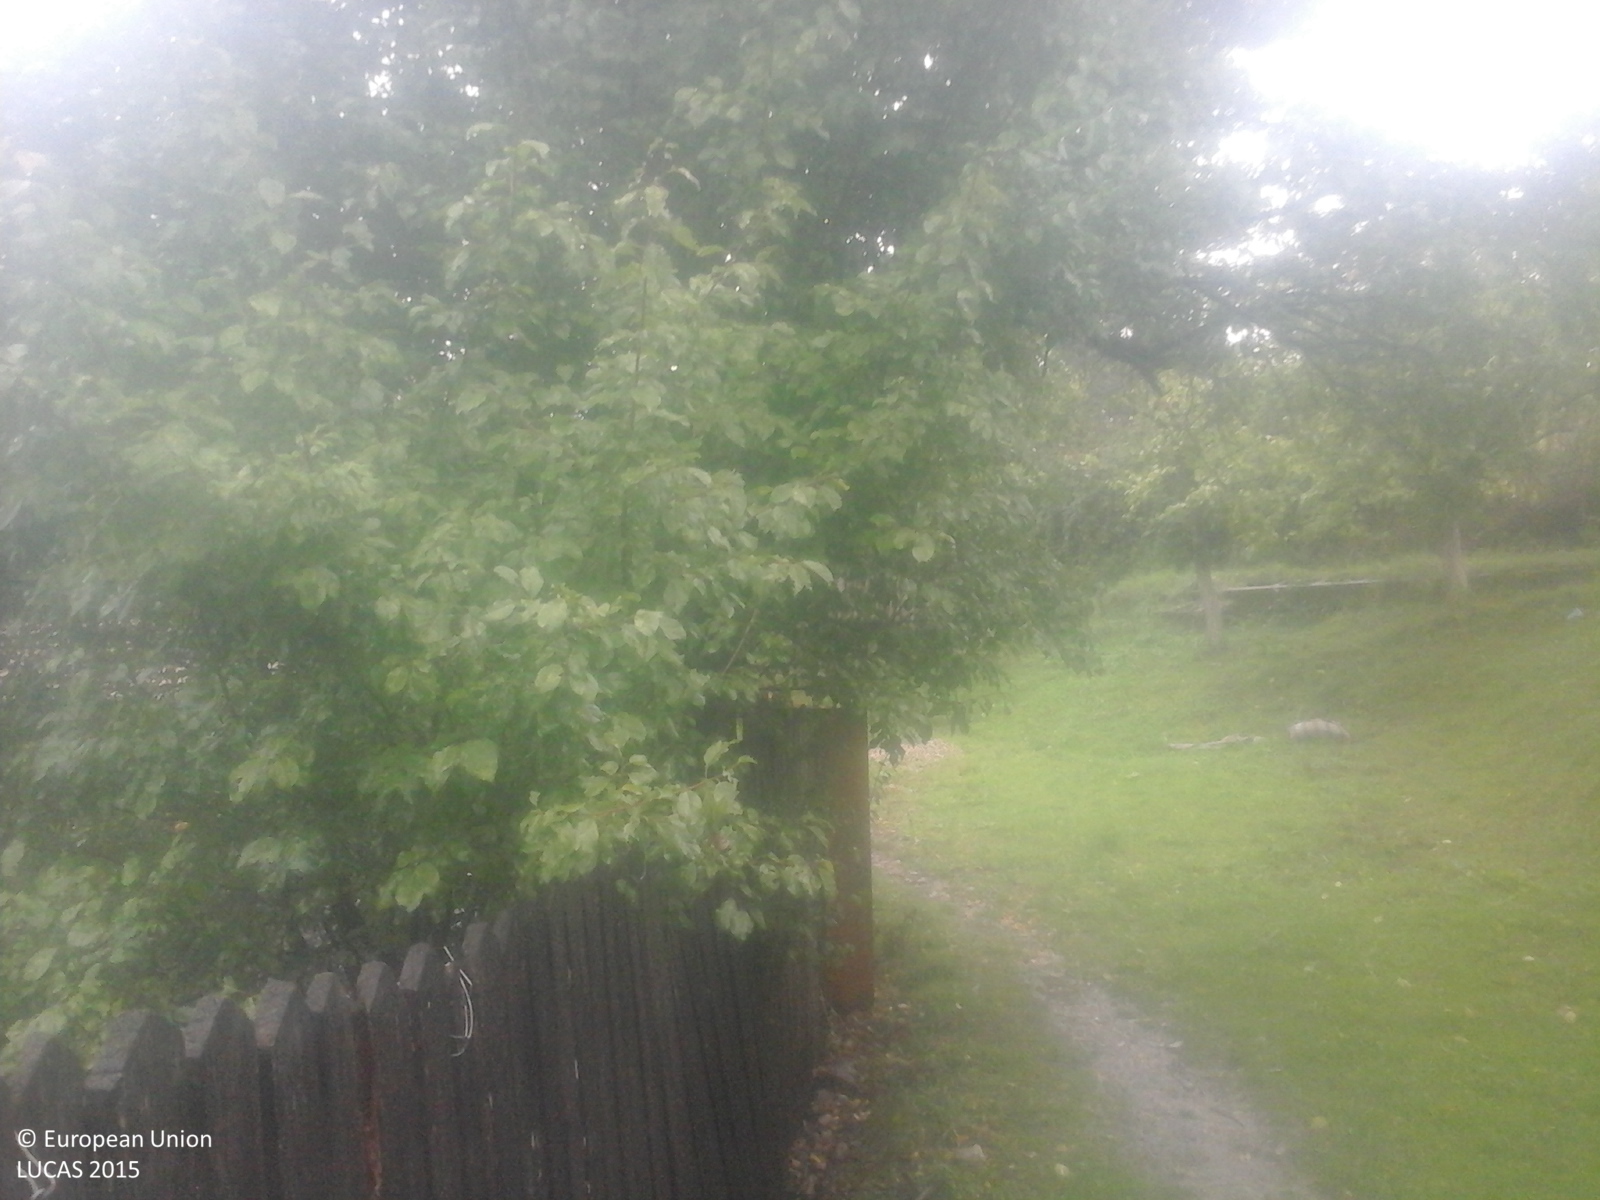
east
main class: Grassland
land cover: Spontaneously vegetated surfaces
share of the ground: > 75 %
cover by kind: herbaceous plants 100 %
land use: Fallow land
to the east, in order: Spontaneously vegetated surfaces; Artificial constructions in urban areas; Abandoned hedges; Maize; Lines of trees; Artificial constructions in urban areas; Permanent crops (only in case pi); Arable land (only in case pi); Spontaneously vegetated surfaces; Arable land (only in case pi); Spontaneously vegetated surfaces; Broadleaved woodland
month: September
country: RO
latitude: 44.9772
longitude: 23.7955
